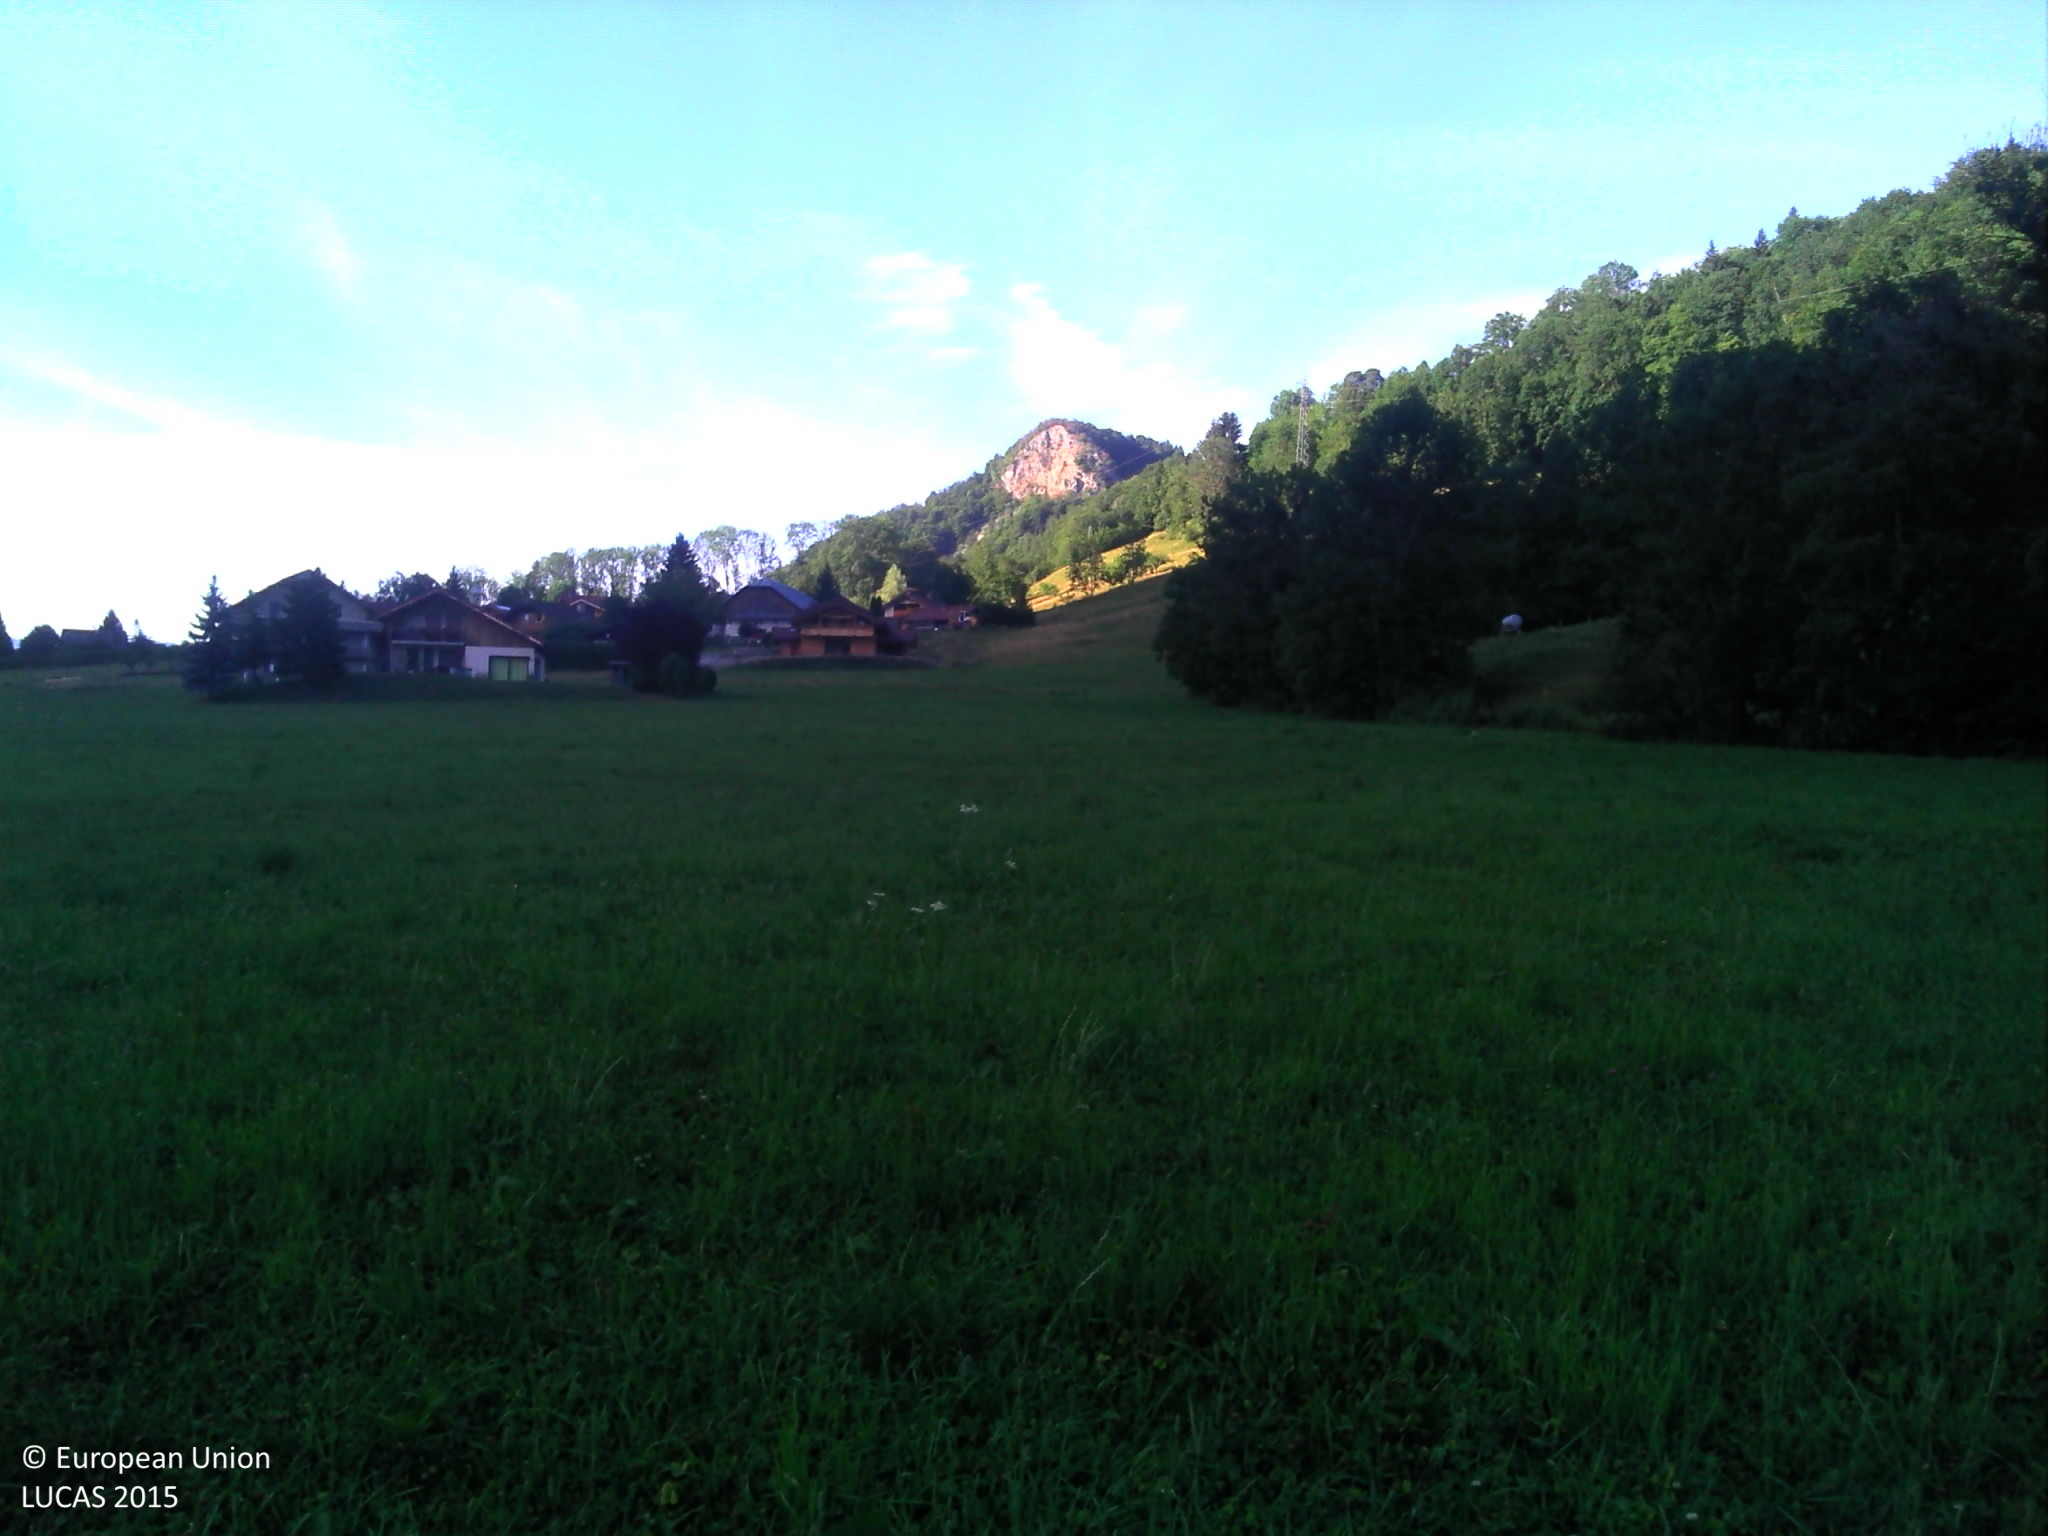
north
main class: Grassland
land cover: Grassland without tree/shrub cover
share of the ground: > 75 %
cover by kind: herbaceous plants 100 %
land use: Agriculture (excluding fallow land and kitchen gardens)
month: July
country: FR
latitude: 45.8196
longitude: 6.3360
